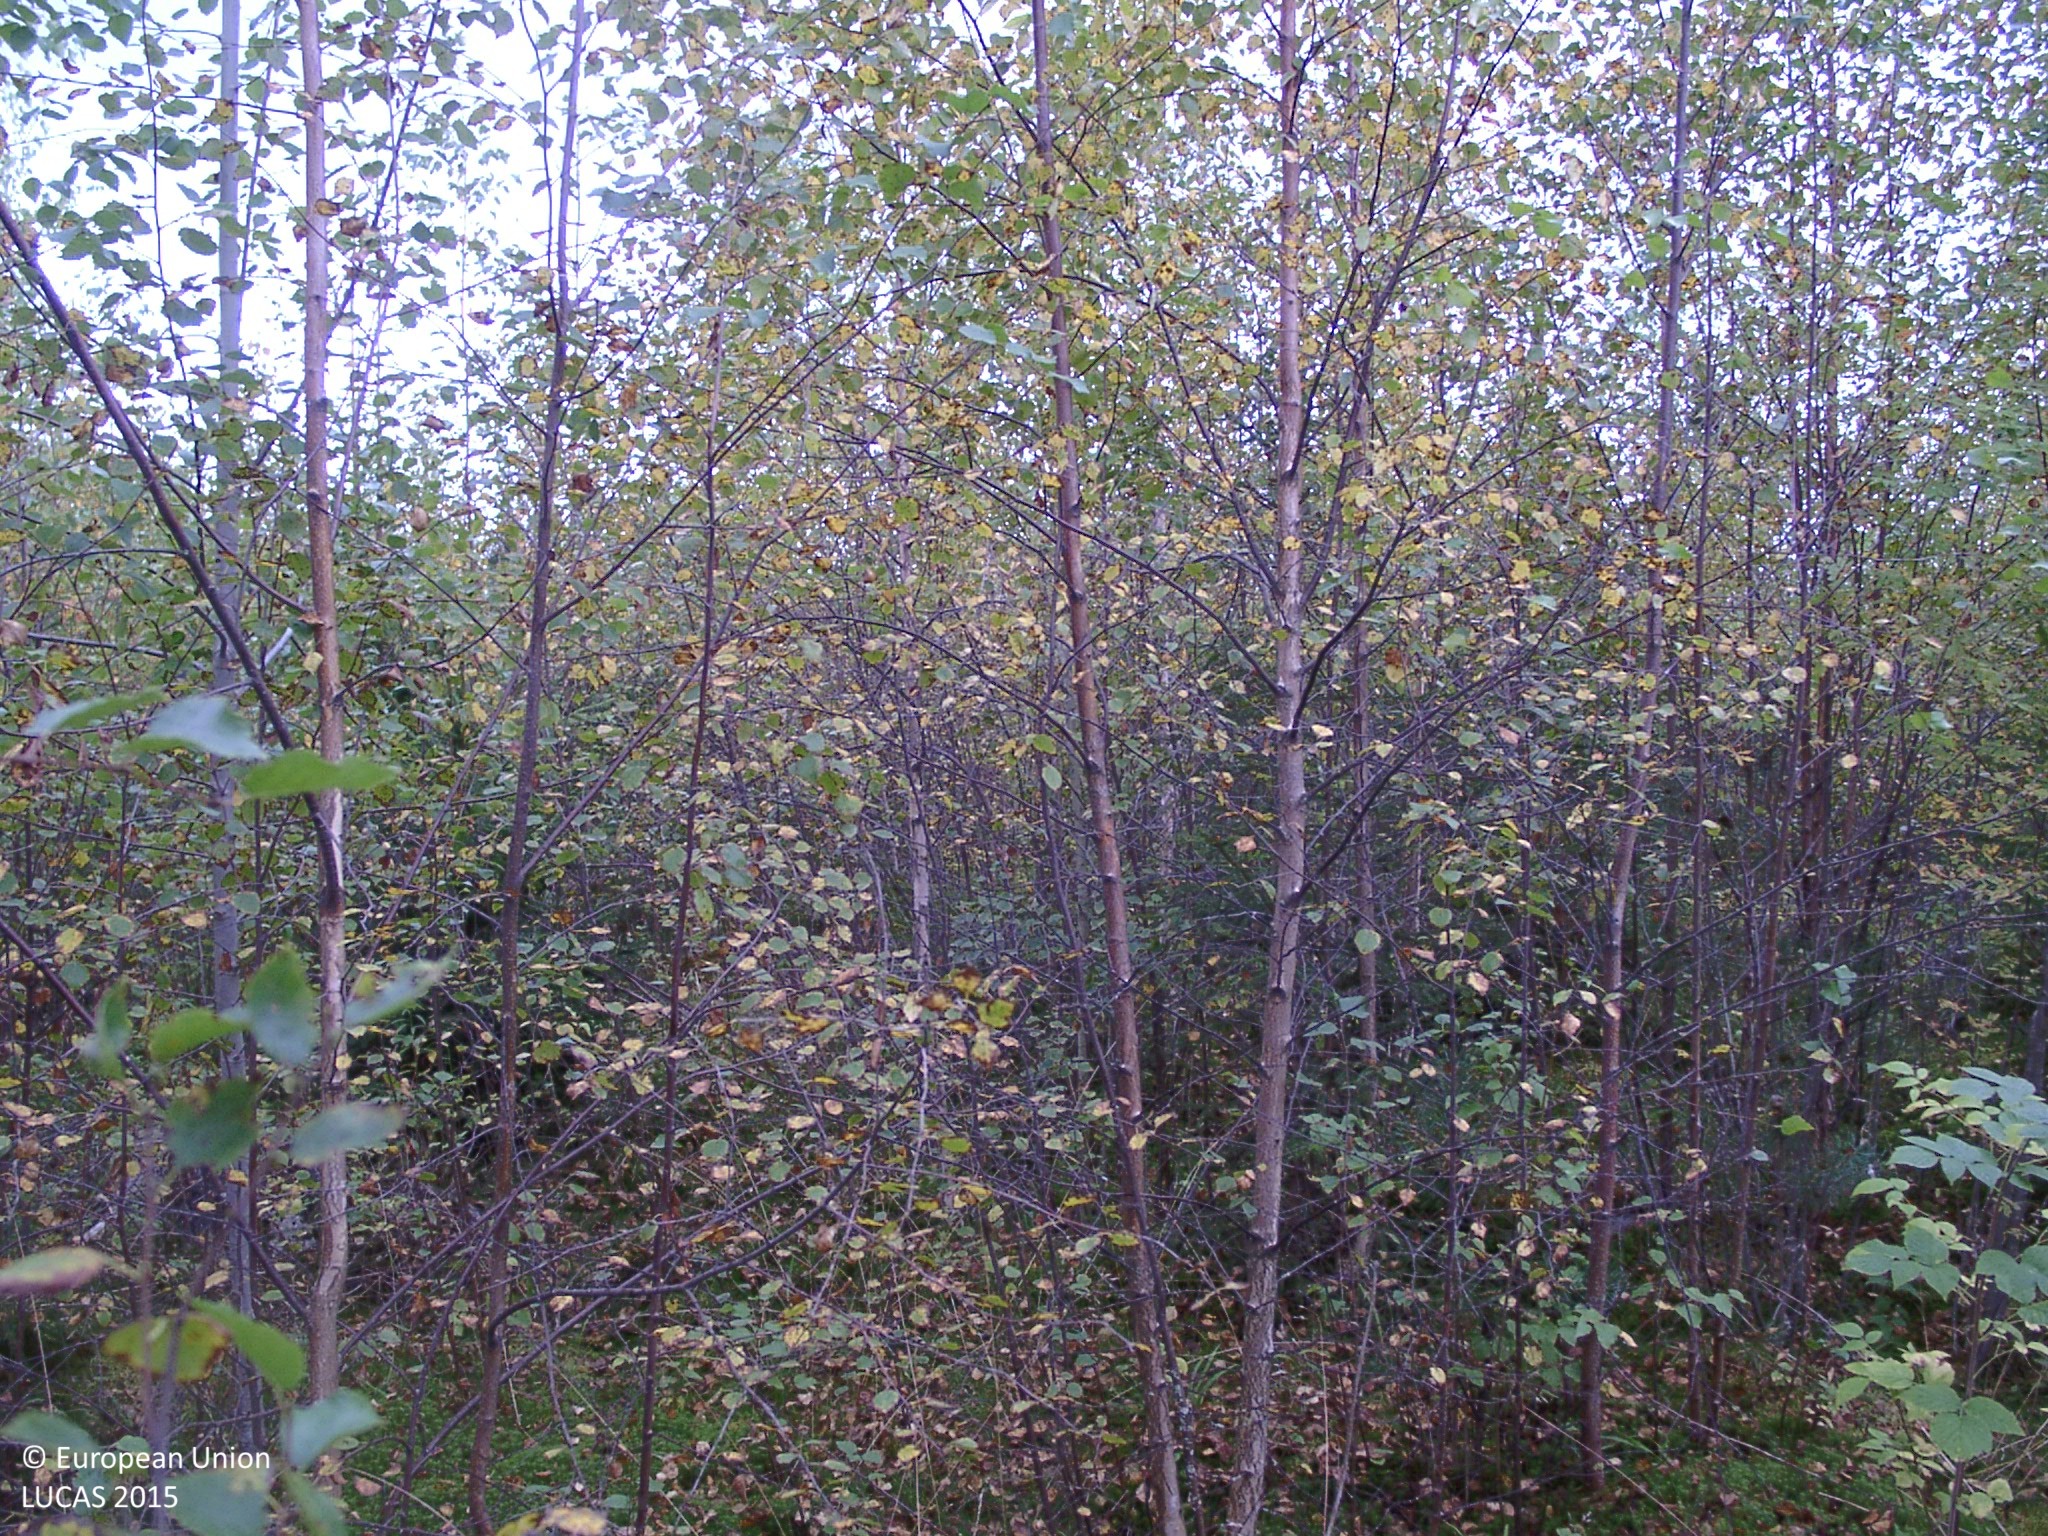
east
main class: Woodland
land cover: Broadleaved woodland
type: boreal forest
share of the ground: 50 - 75 %
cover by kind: broadleaved forest trees 60 %, lichens and mosses 20 %, coniferous forest trees 5 %, shrubs 5 %, herbaceous plants 5 %
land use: Forestry
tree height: < 5 m
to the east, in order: Broadleaved woodland; Tracks; Broadleaved woodland; Other mixed woodland; Ditches and canals; Spruce dominated mixed woodland; Ditches and canals; Other mixed woodland; Inland fresh water bodies
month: September
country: FI
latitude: 62.8784
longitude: 25.2618
